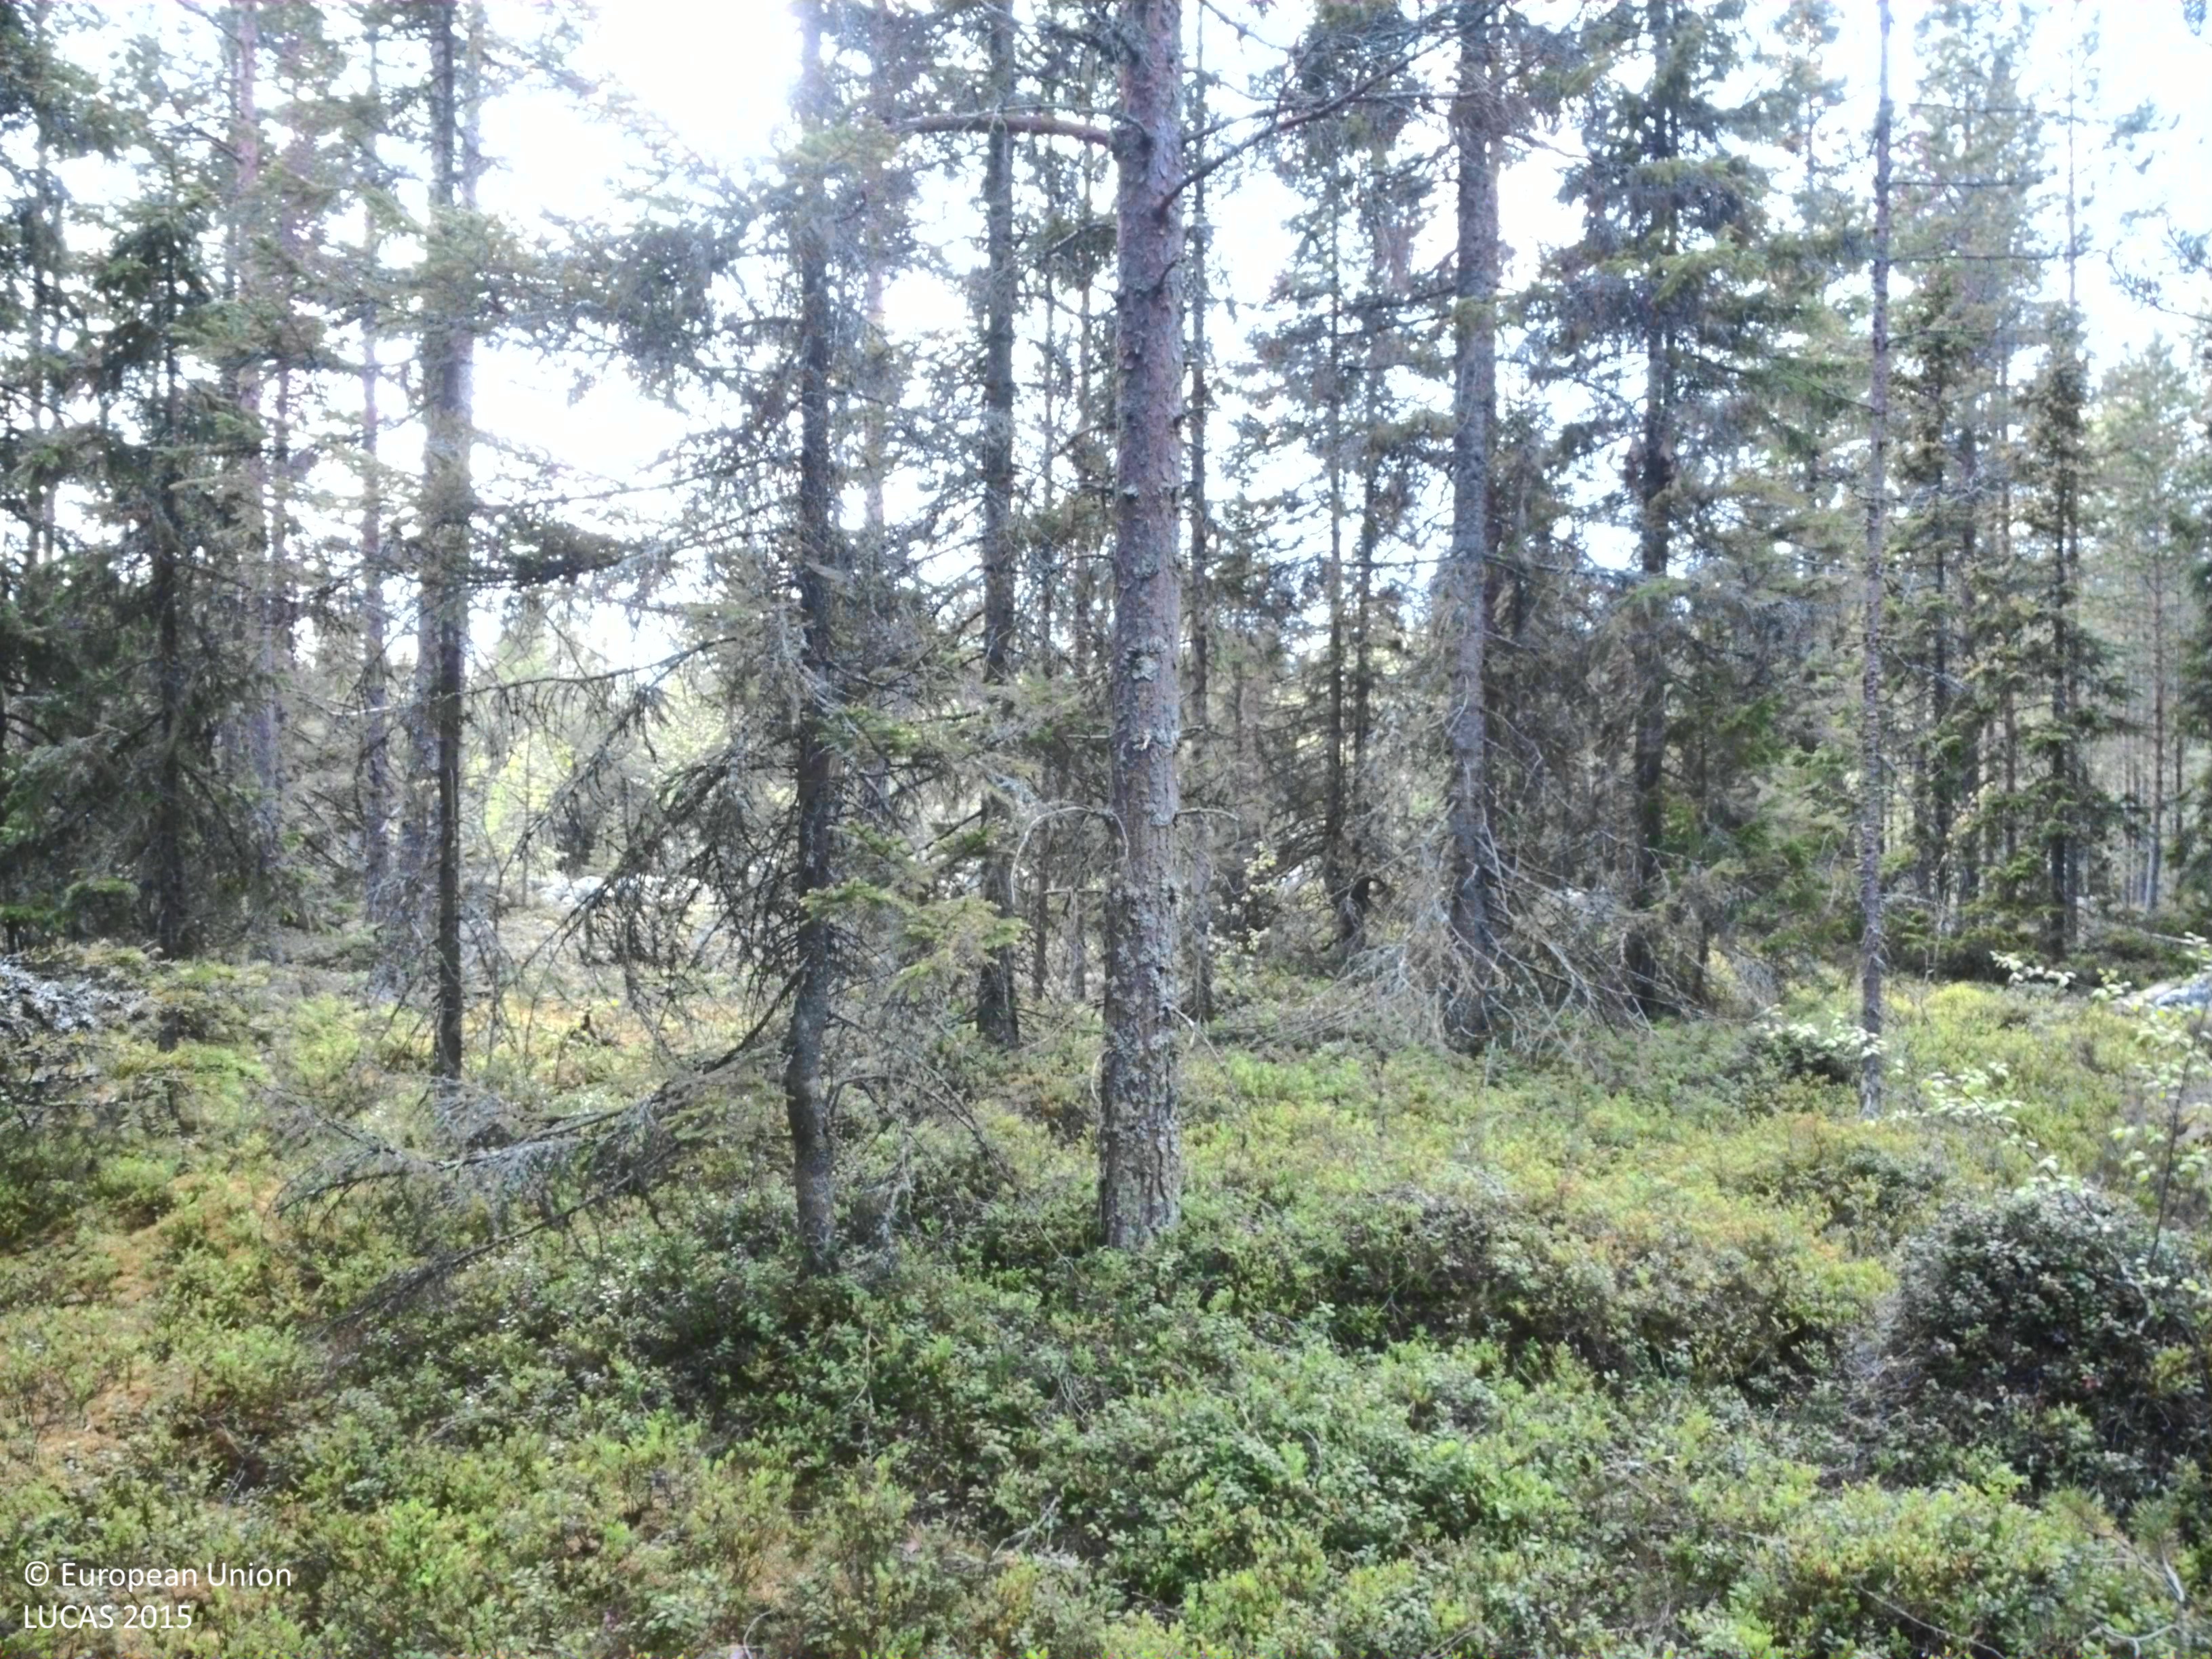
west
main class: Woodland
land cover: Other coniferous woodland
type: boreal forest
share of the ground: 25 - 50 %
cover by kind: coniferous forest trees 50 %, shrubs 40 %, herbaceous plants 5 %, lichens and mosses 5 %
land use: Amenities, museums, leisure
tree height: > 5 m
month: June
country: SE
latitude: 63.8201
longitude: 20.6503
